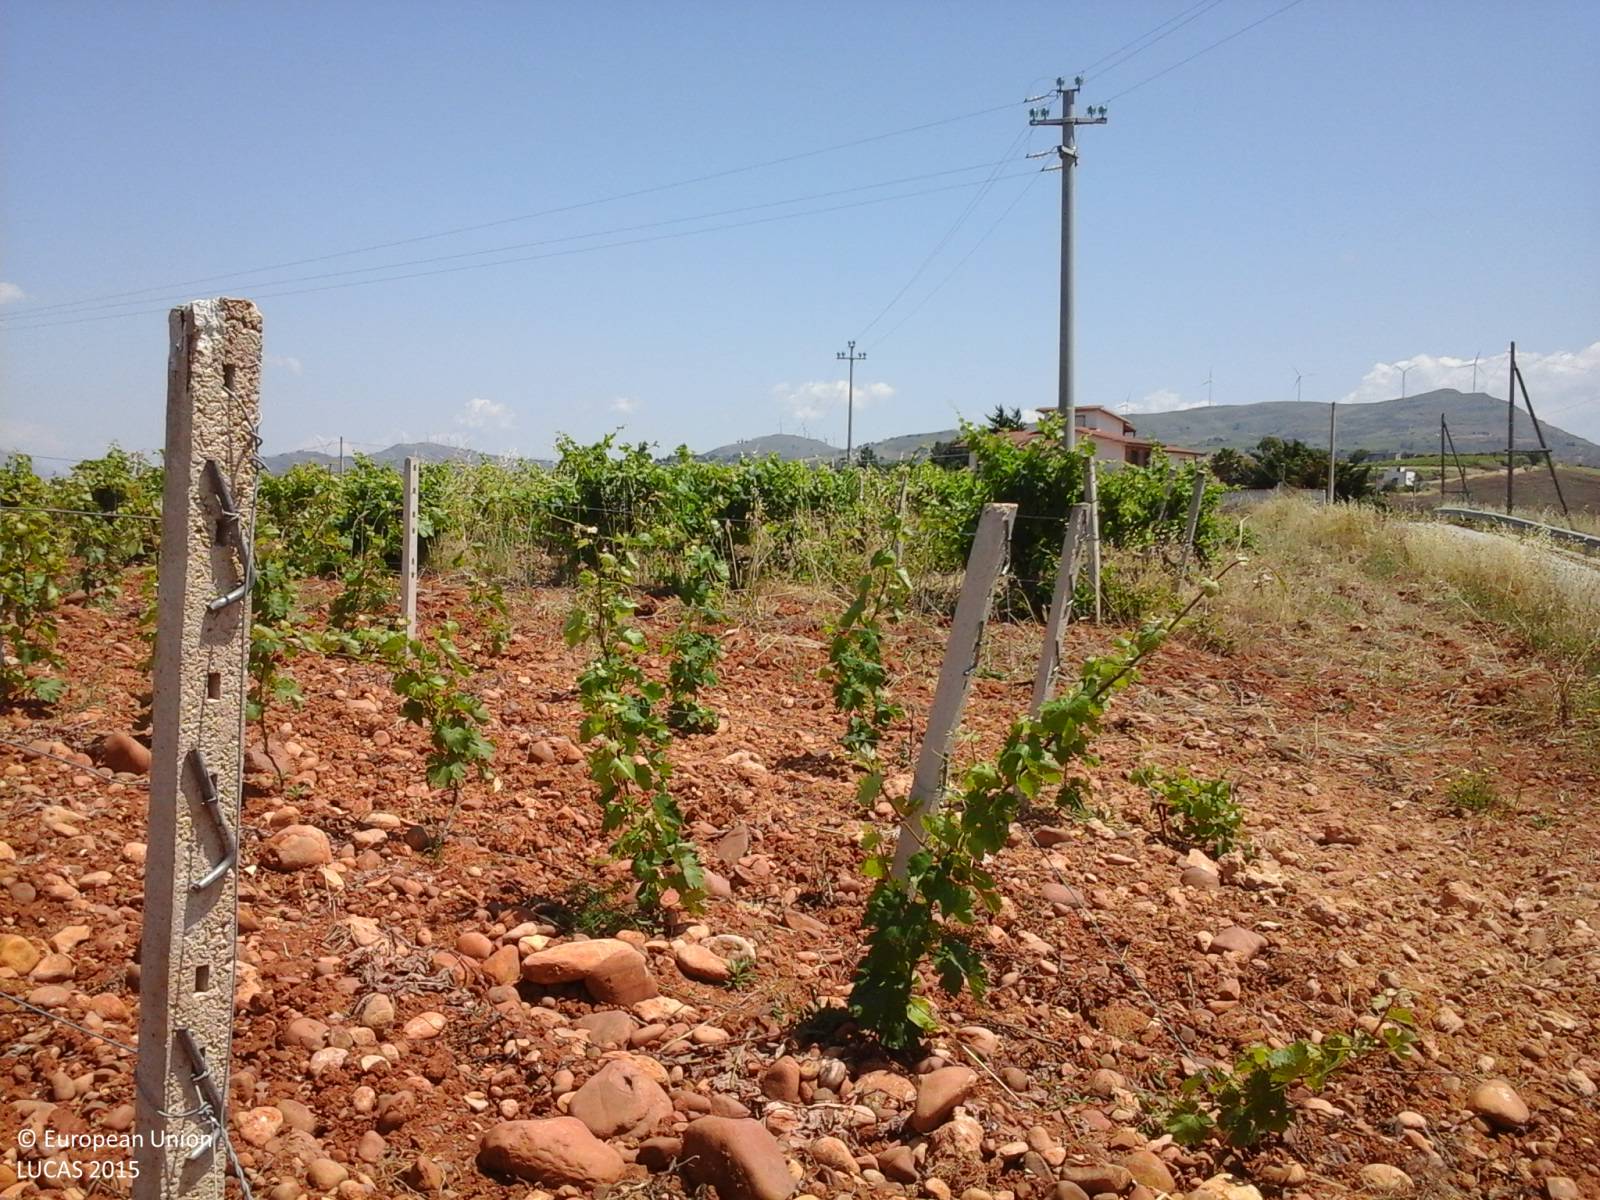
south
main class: Cropland
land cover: Vineyards
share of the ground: 25 - 50 %
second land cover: Other bare soil
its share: > 75 %
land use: Agriculture (excluding fallow land and kitchen gardens)
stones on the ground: > 50 %
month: June
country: IT
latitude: 37.9910
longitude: 12.9959
